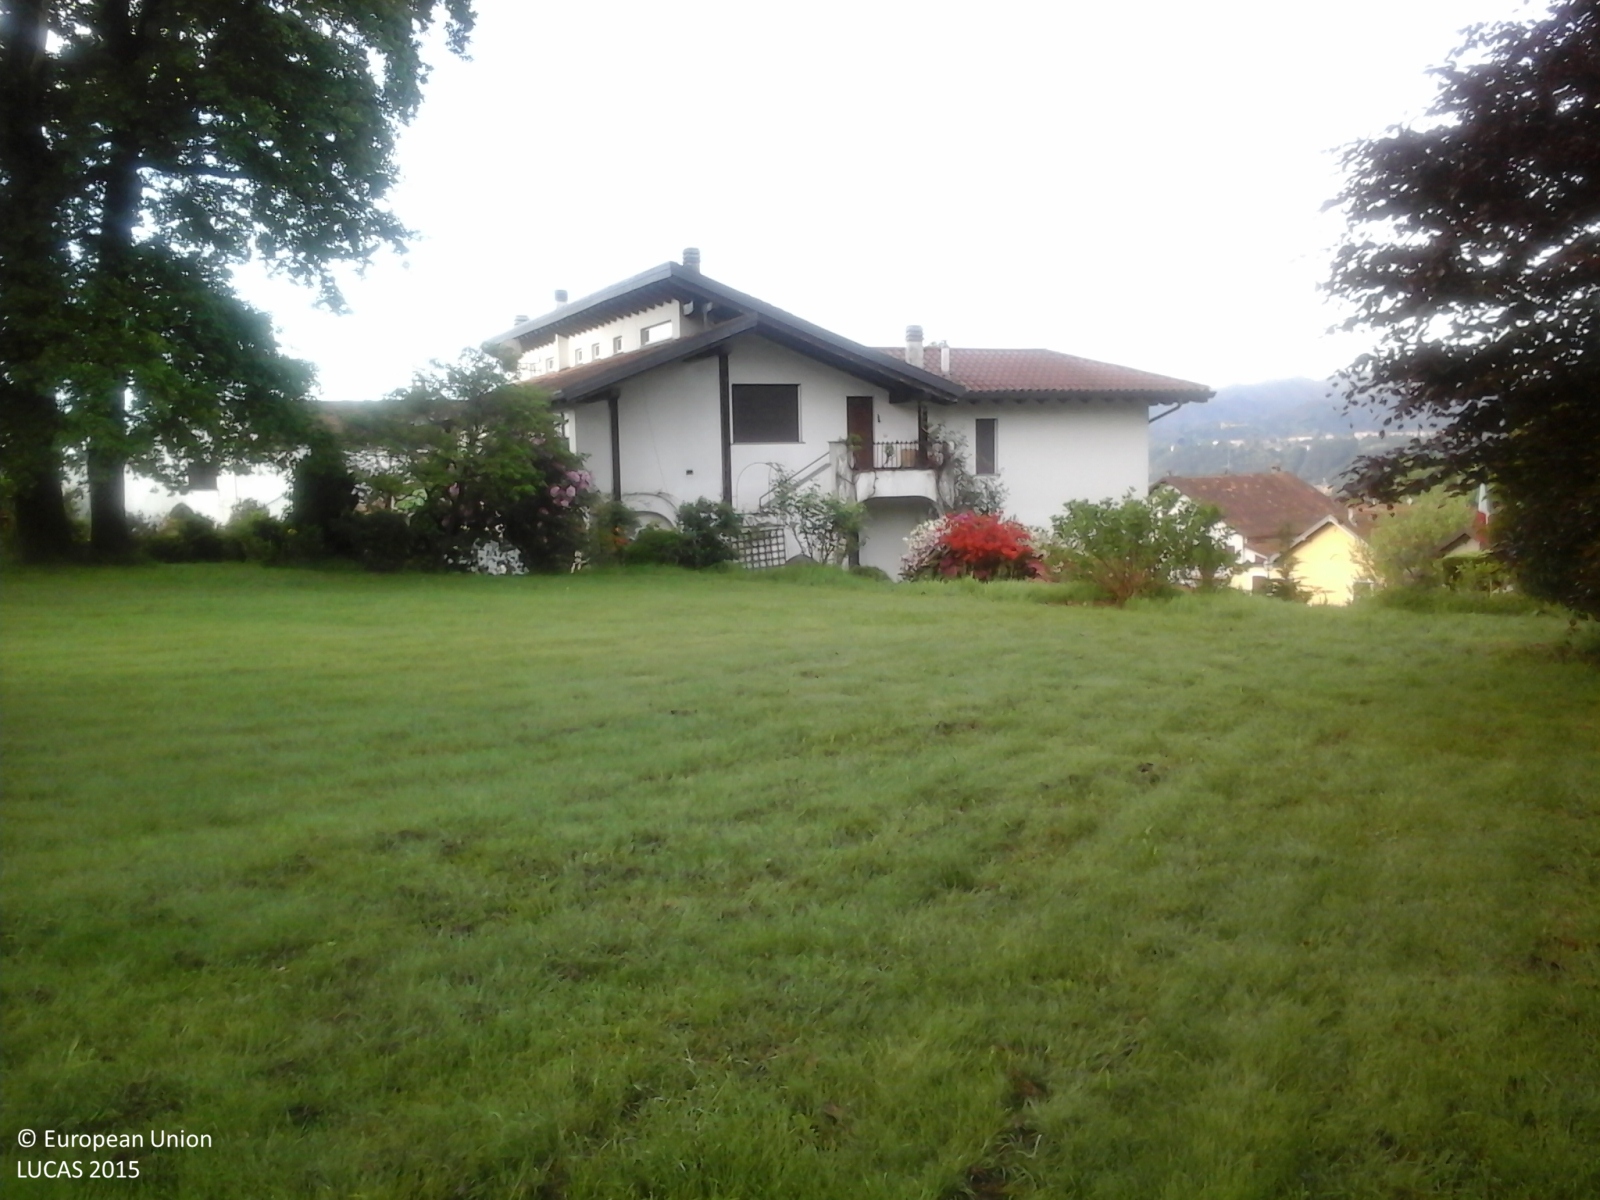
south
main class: Woodland
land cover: Broadleaved woodland
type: mesophytic deciduous forest
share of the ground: > 75 %
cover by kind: broadleaved forest trees 95 %, herbaceous plants 5 %
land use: Residential
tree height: > 5 m
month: May
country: IT
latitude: 45.7633
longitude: 8.4466
